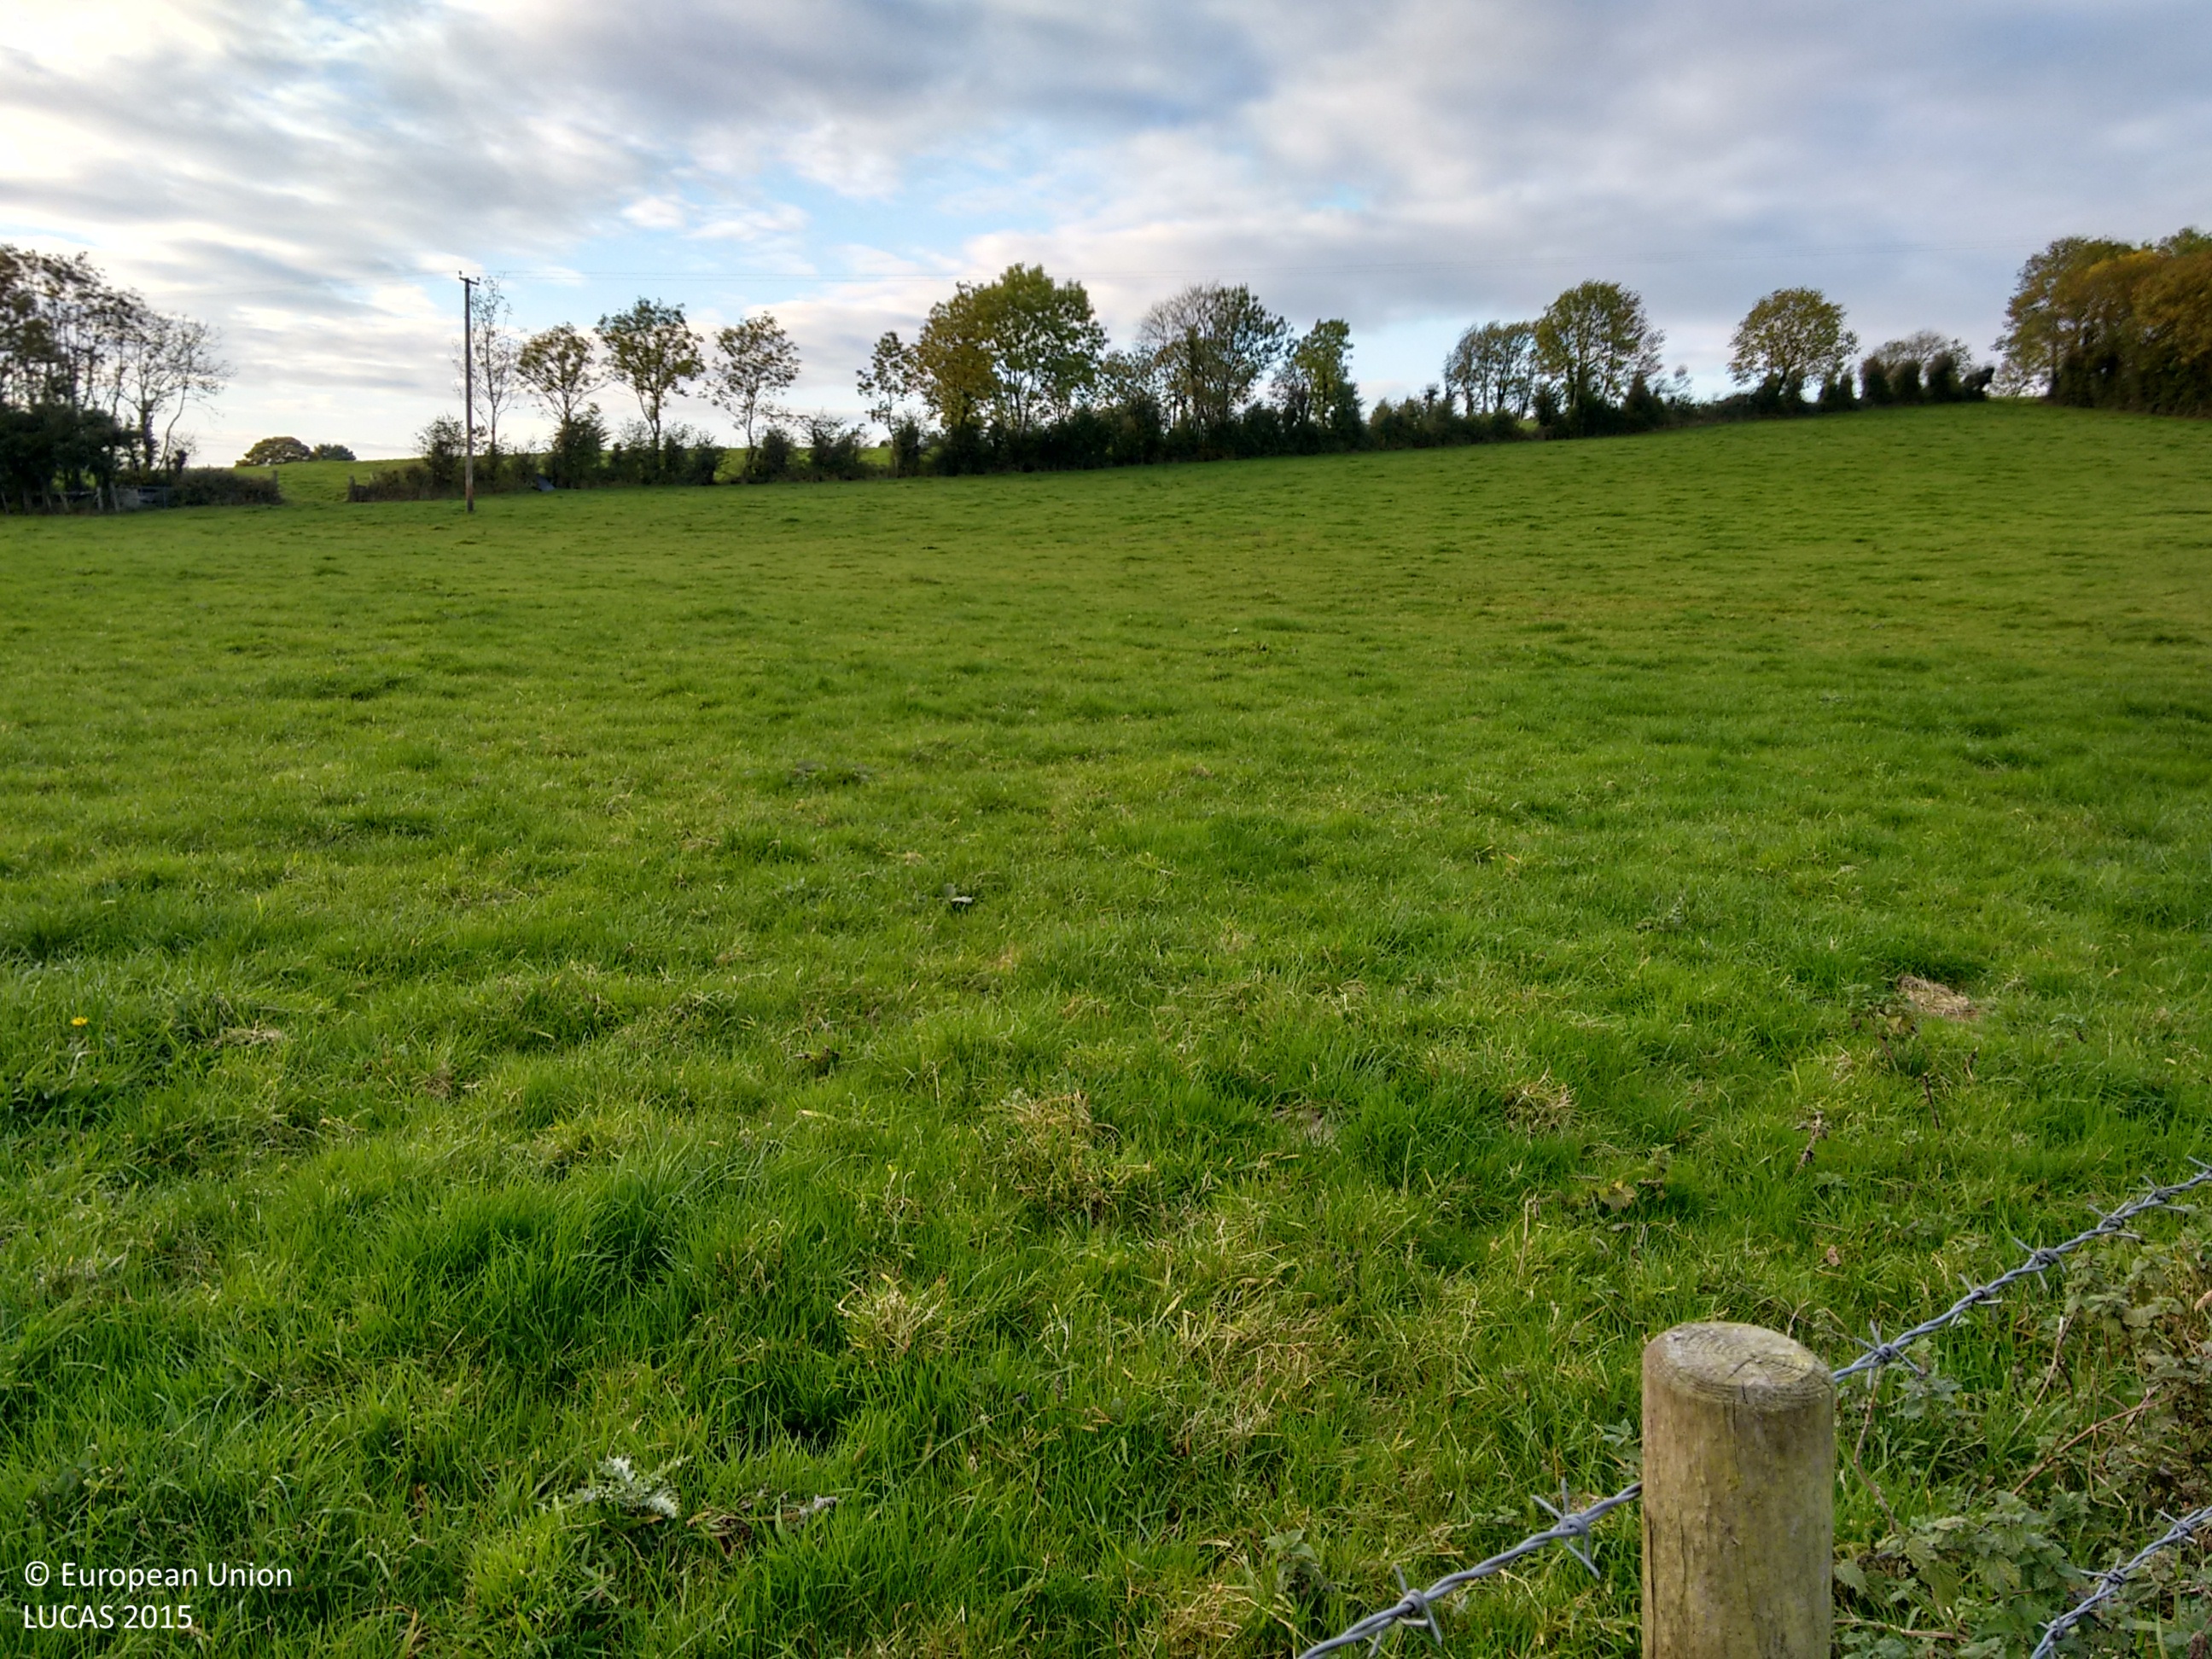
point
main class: Grassland
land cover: Grassland without tree/shrub cover
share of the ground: > 75 %
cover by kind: herbaceous plants 100 %
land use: Agriculture (excluding fallow land and kitchen gardens)
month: October
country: GB
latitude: 54.1444
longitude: -7.3432
